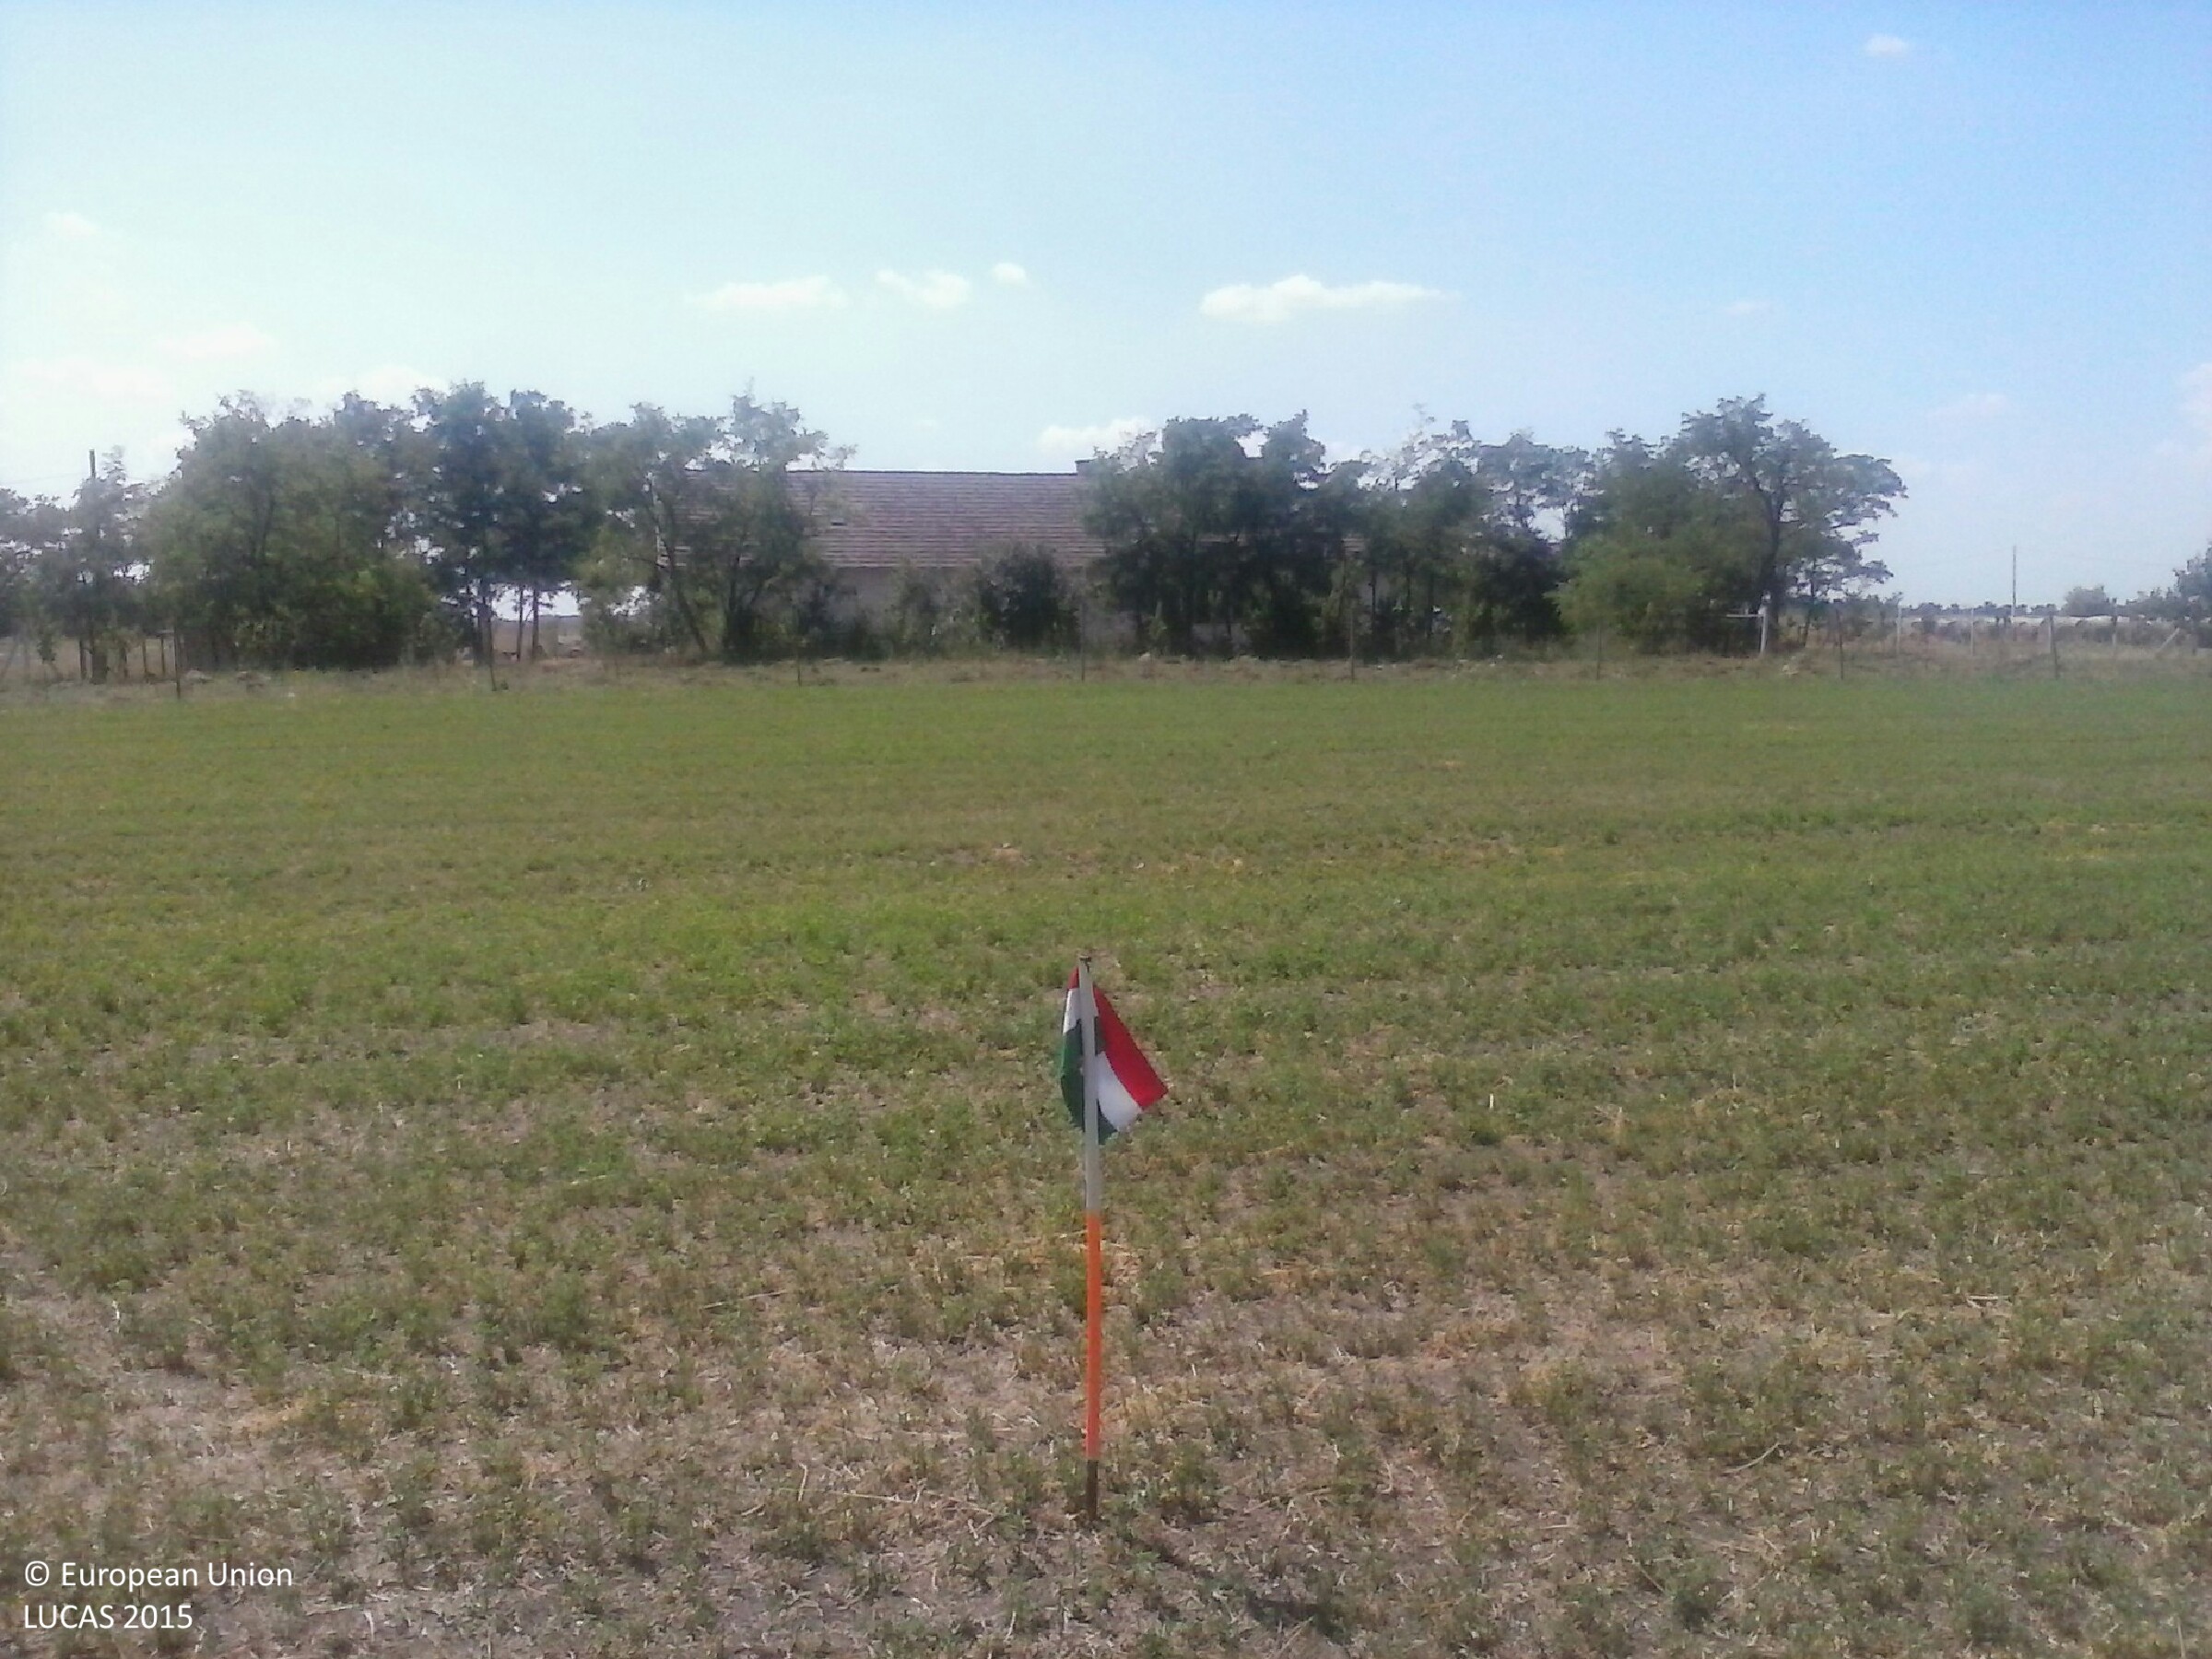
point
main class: Cropland
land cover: Lucerne
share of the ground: > 75 %
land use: Agriculture (excluding fallow land and kitchen gardens)
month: July
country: HU
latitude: 46.6880
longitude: 20.1046
